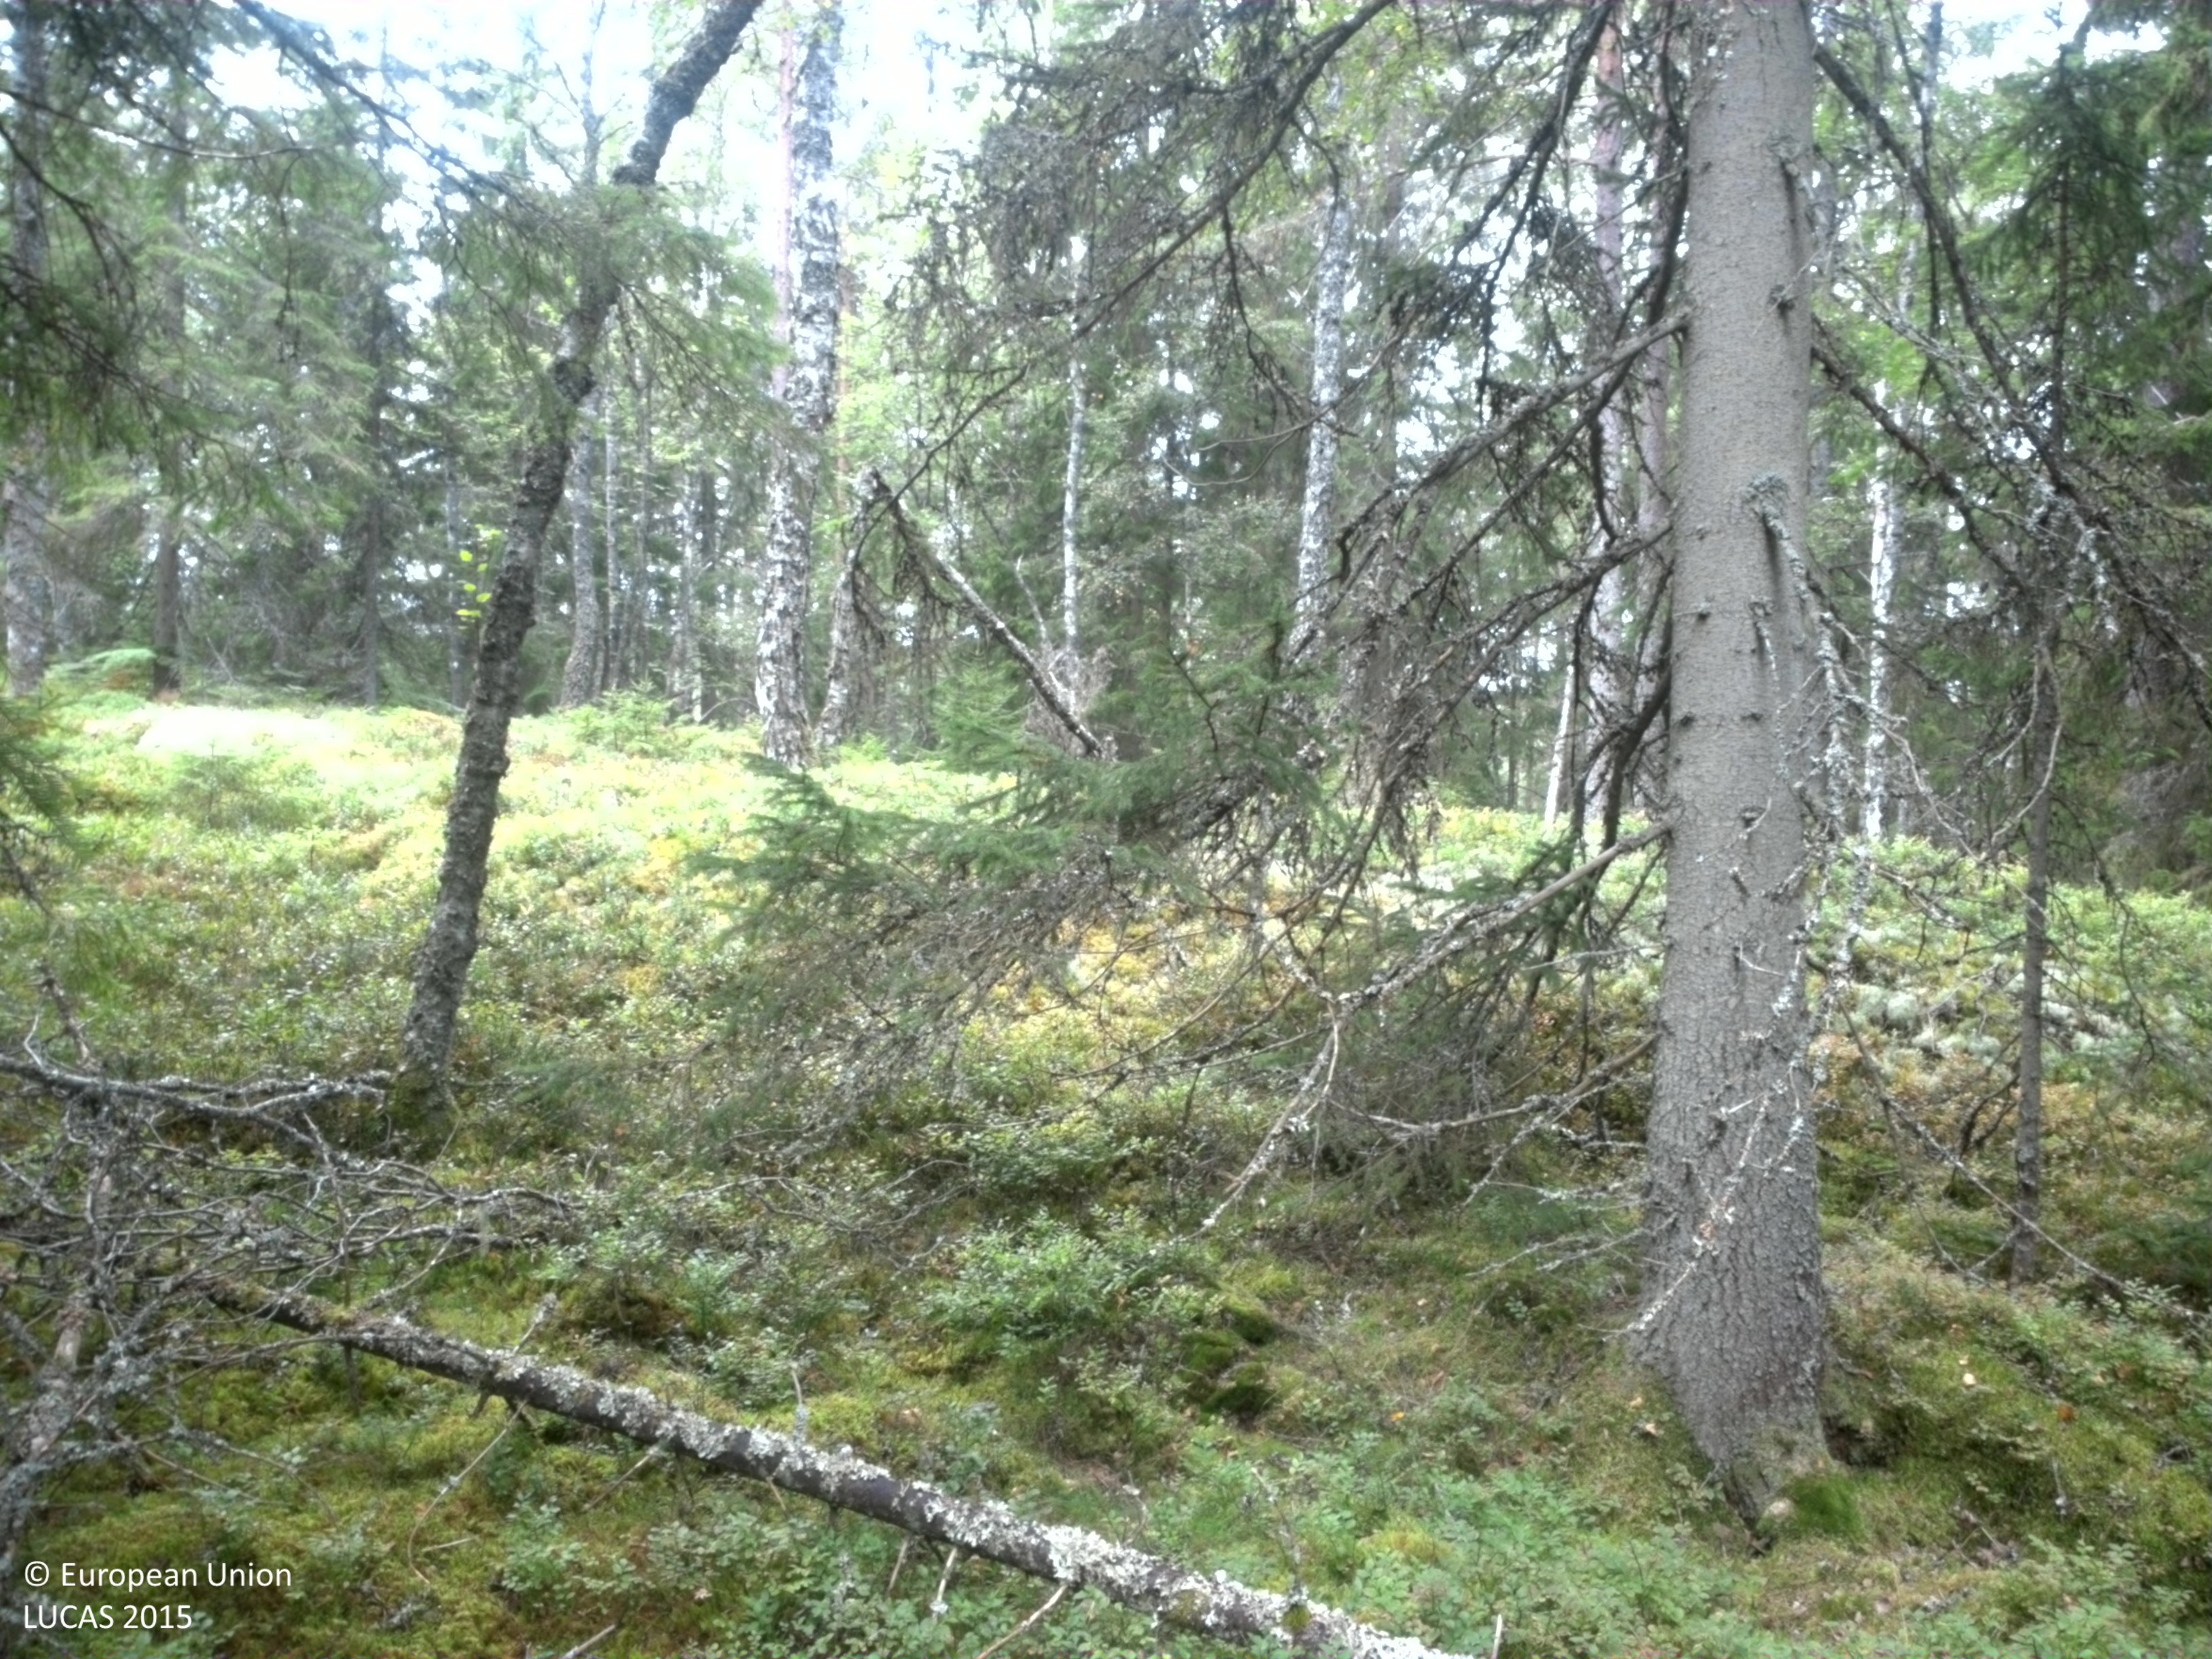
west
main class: Woodland
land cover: Spruce dominated coniferous woodland
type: boreal forest
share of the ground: 50 - 75 %
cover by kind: coniferous forest trees 50 %, lichens and mosses 35 %, shrubs 10 %, broadleaved forest trees 5 %
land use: Forestry
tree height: > 5 m
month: August
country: SE
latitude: 57.8193
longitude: 13.9510
